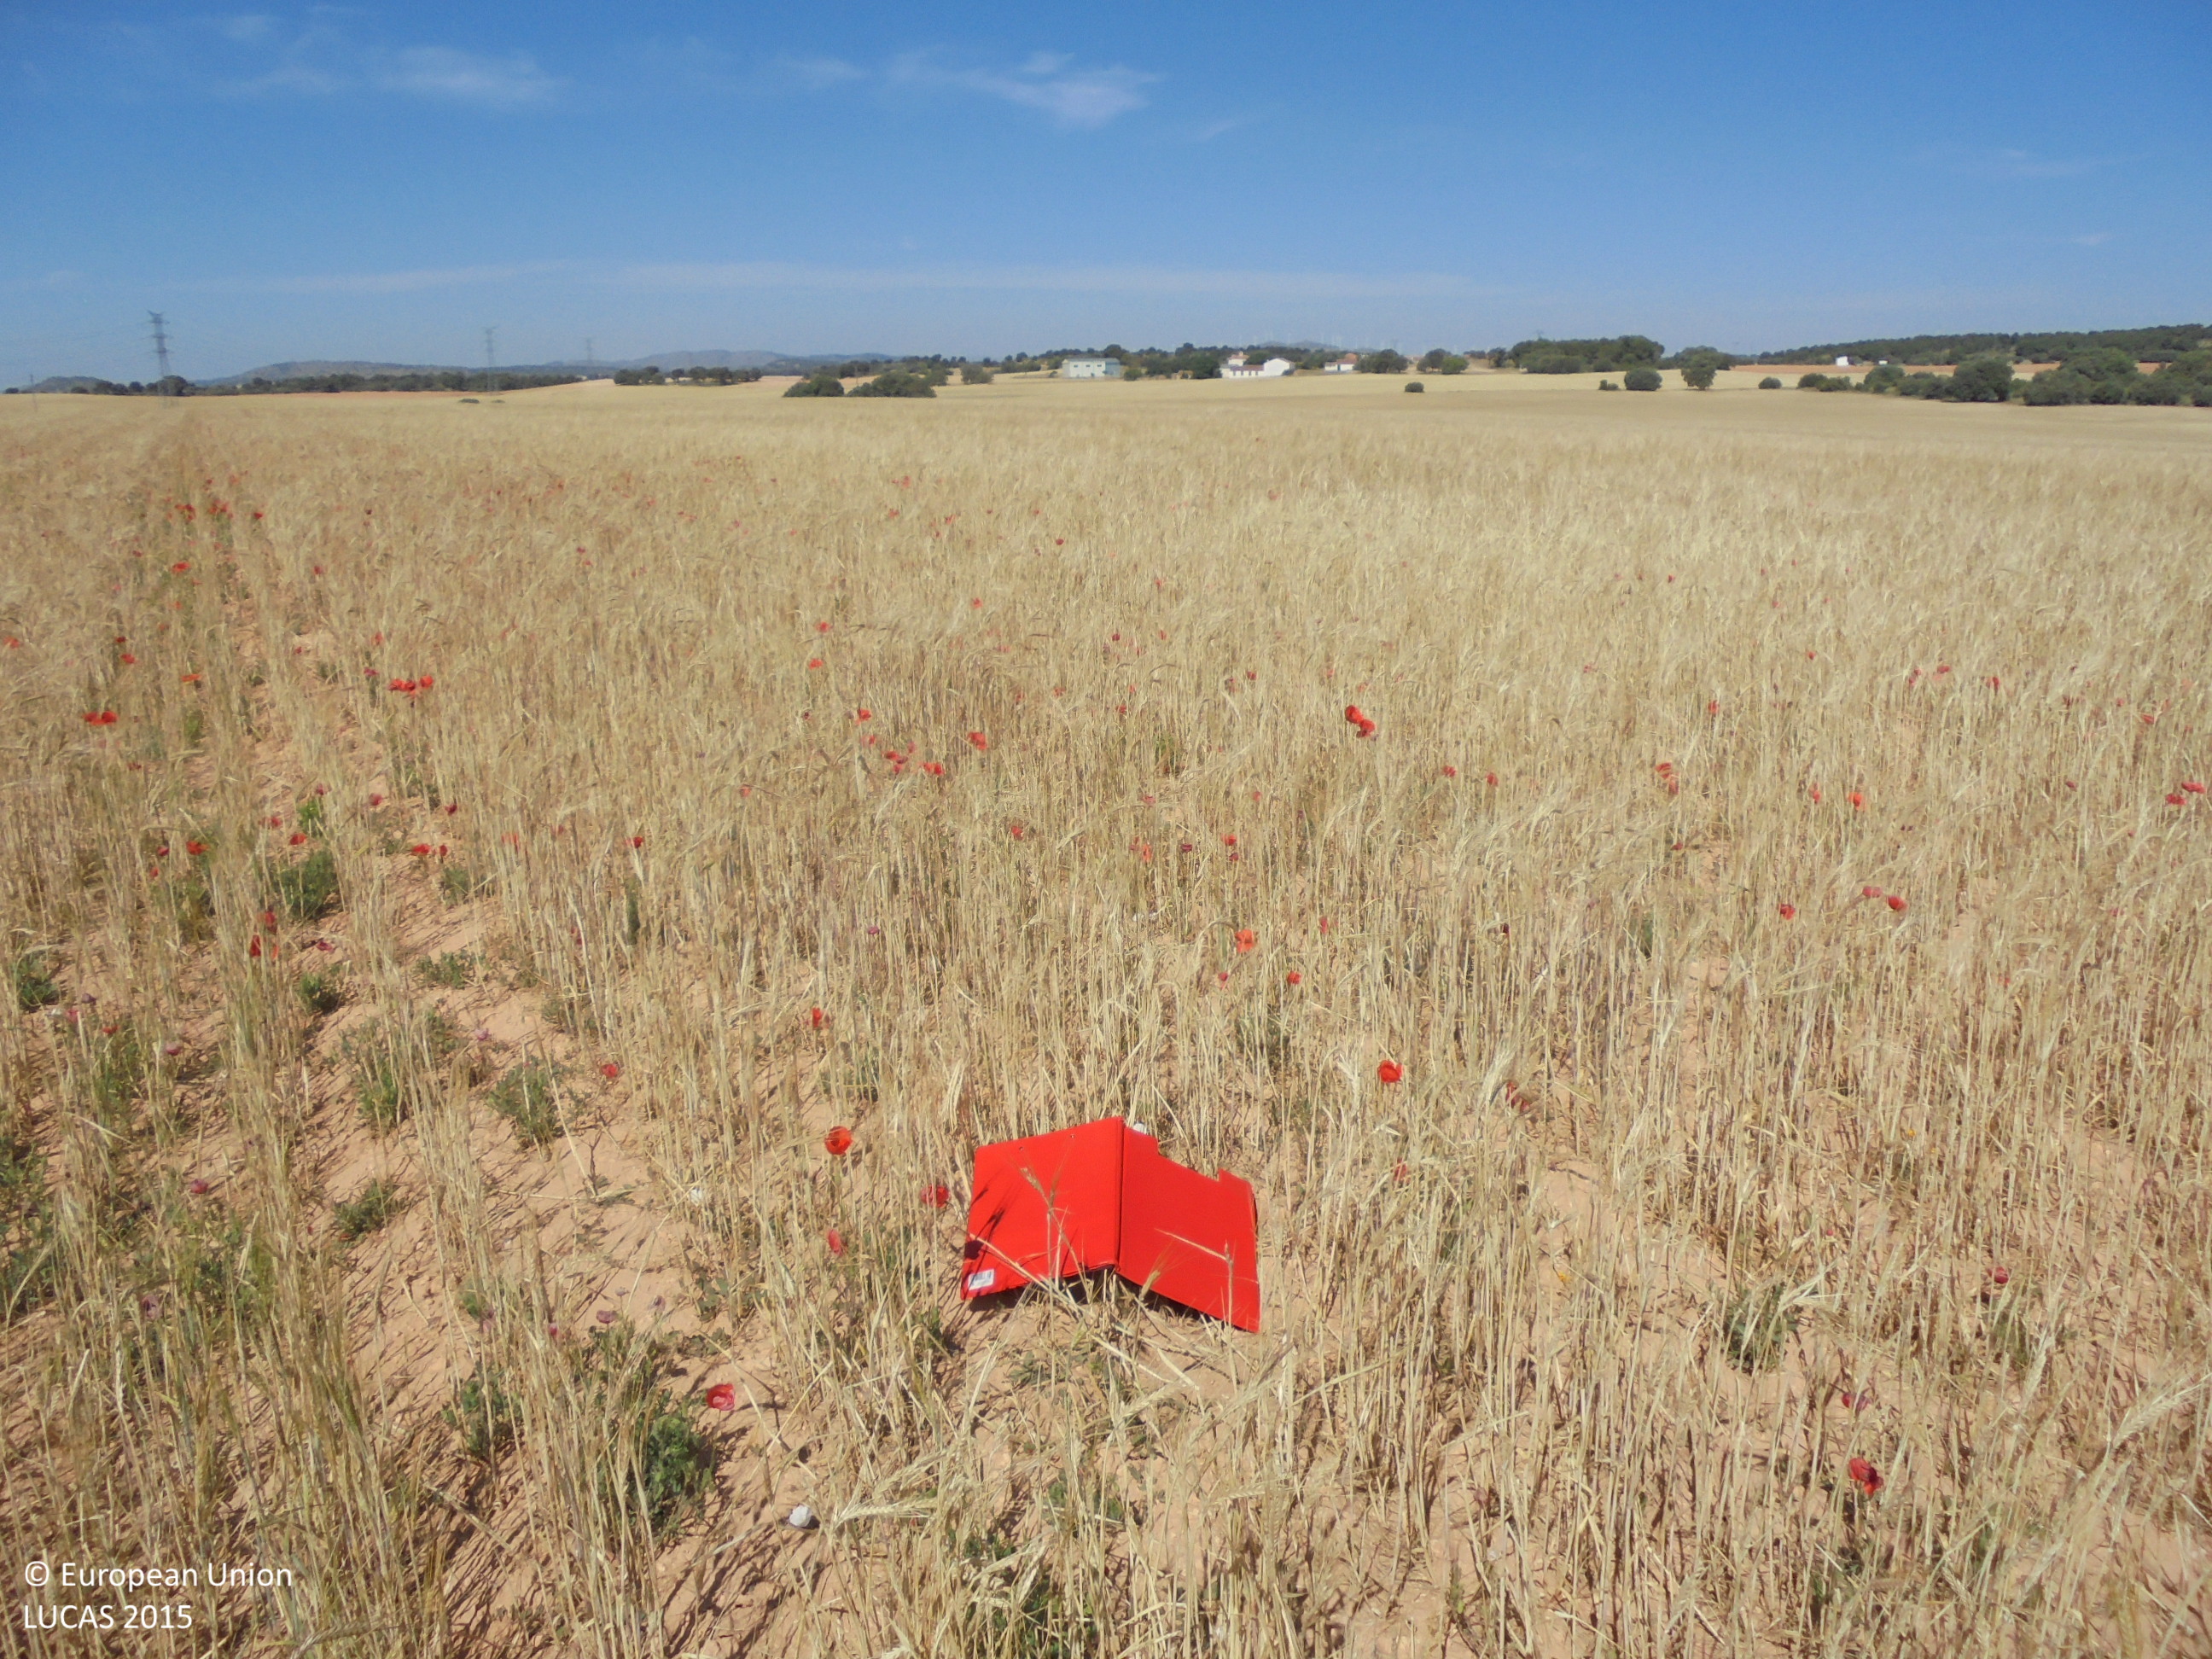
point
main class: Cropland
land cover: Barley
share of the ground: 25 - 50 %
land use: Agriculture (excluding fallow land and kitchen gardens)
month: June
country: ES
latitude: 38.7690
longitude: -1.6321
